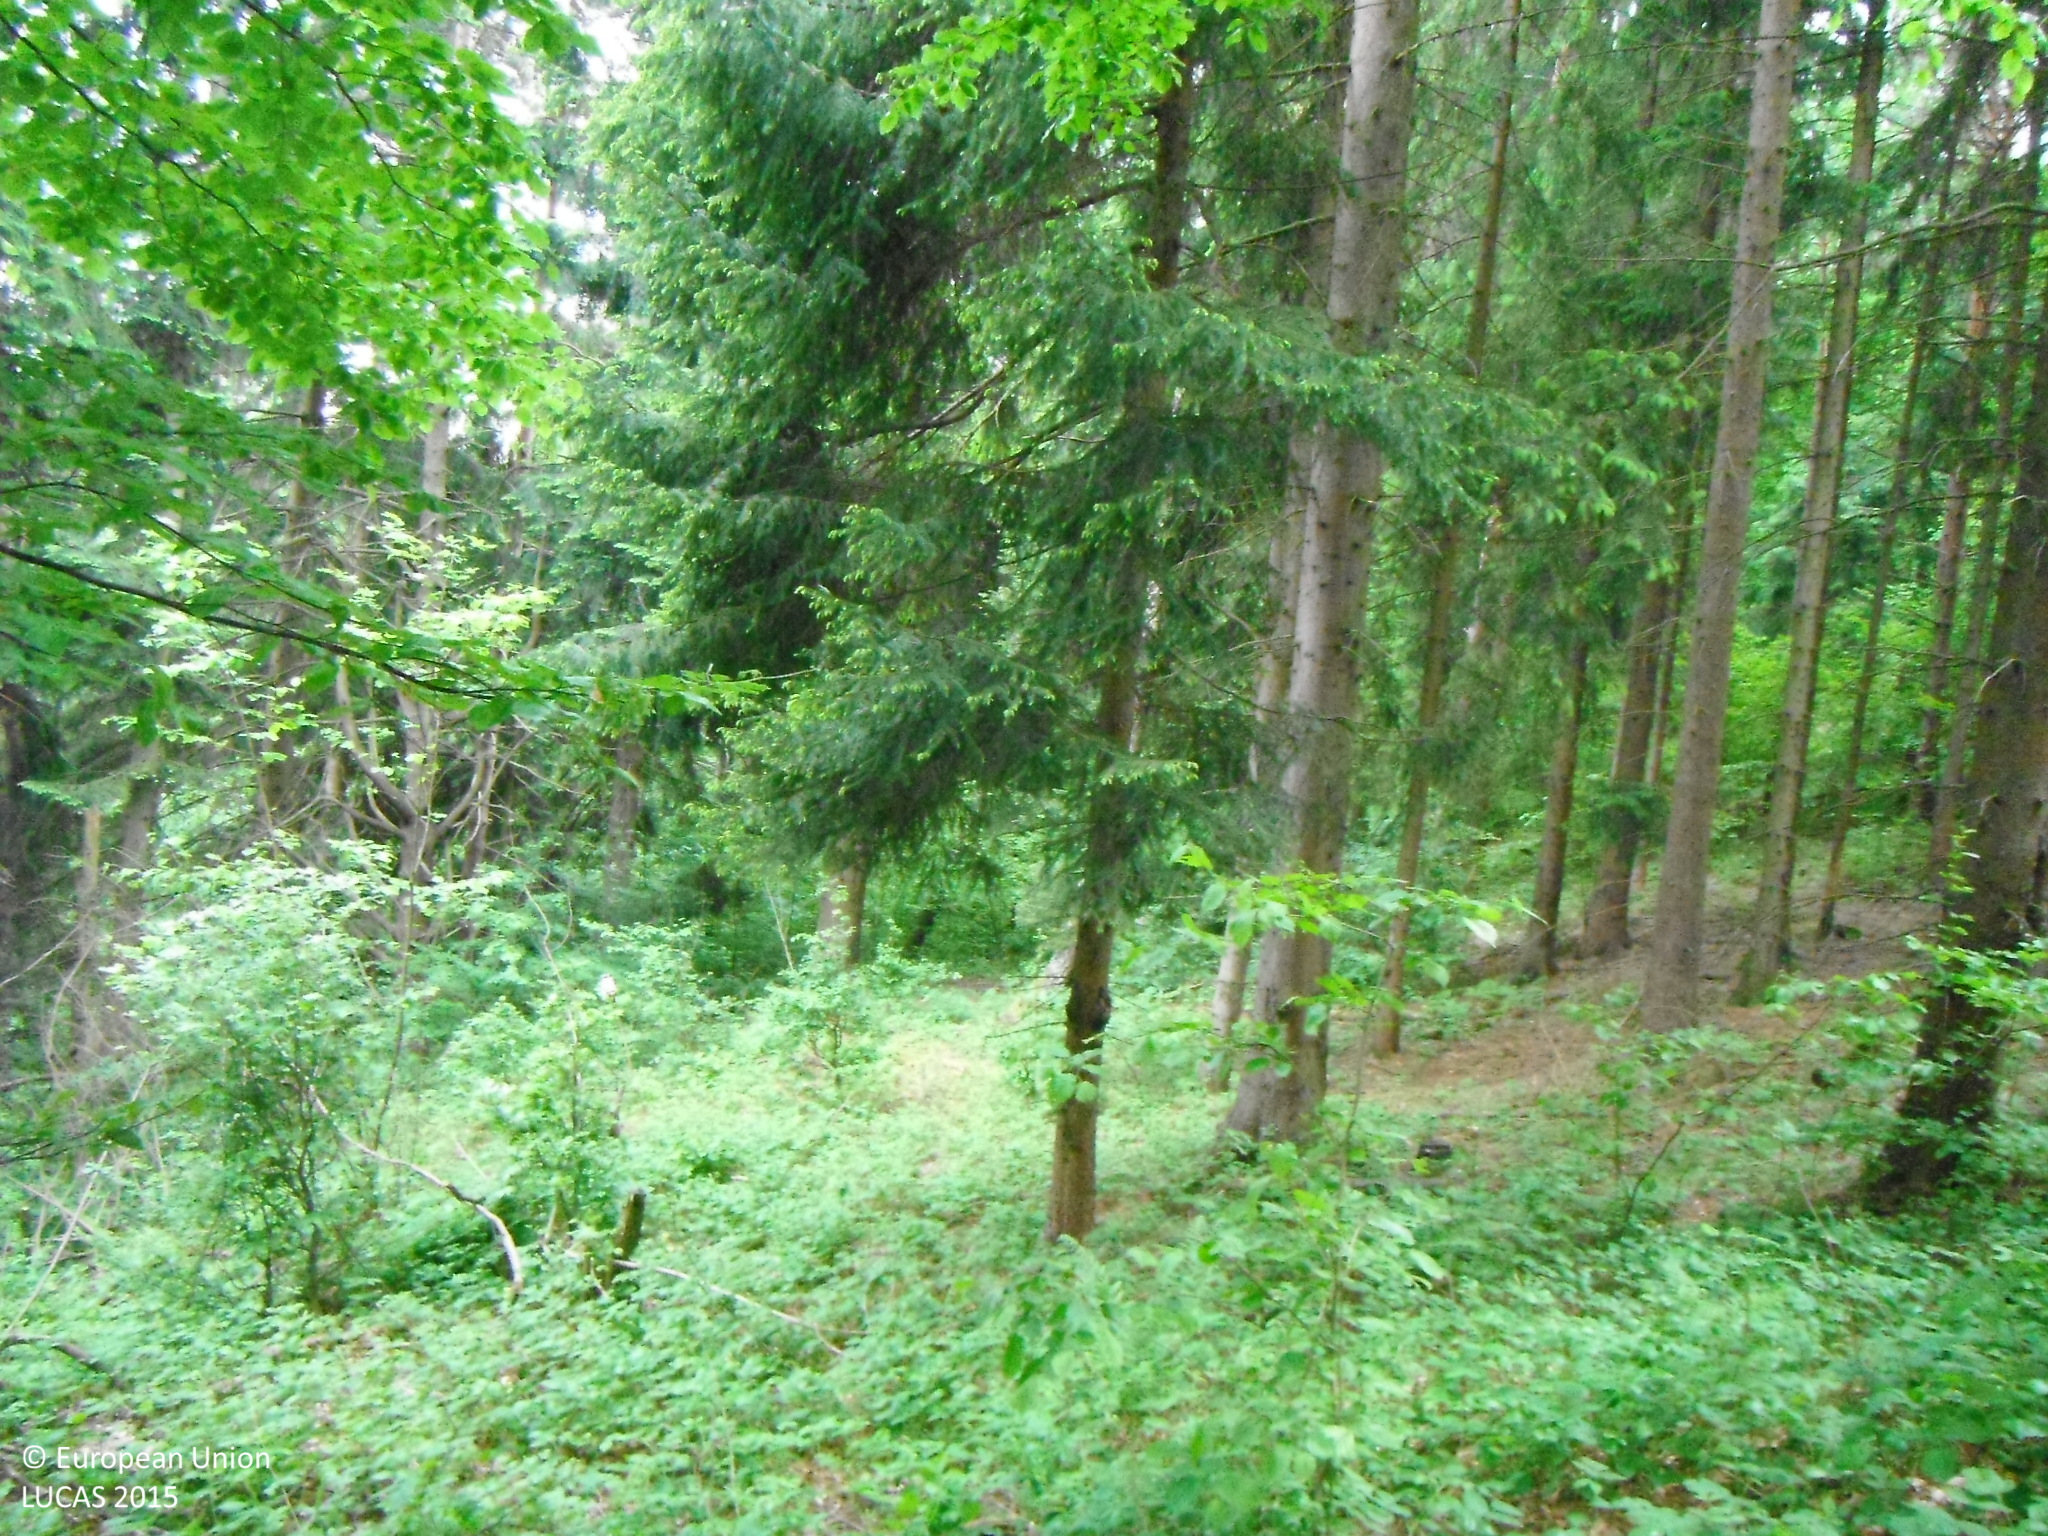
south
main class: Woodland
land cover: Pine dominated mixed woodland
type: hemiboreal forest and nemoral coniferous forest and mixed broadleaved-coniferous forest
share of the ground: > 75 %
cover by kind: coniferous forest trees 50 %, broadleaved forest trees 50 %
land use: Forestry
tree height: > 5 m
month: June
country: SK
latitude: 48.7941
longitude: 18.7998
